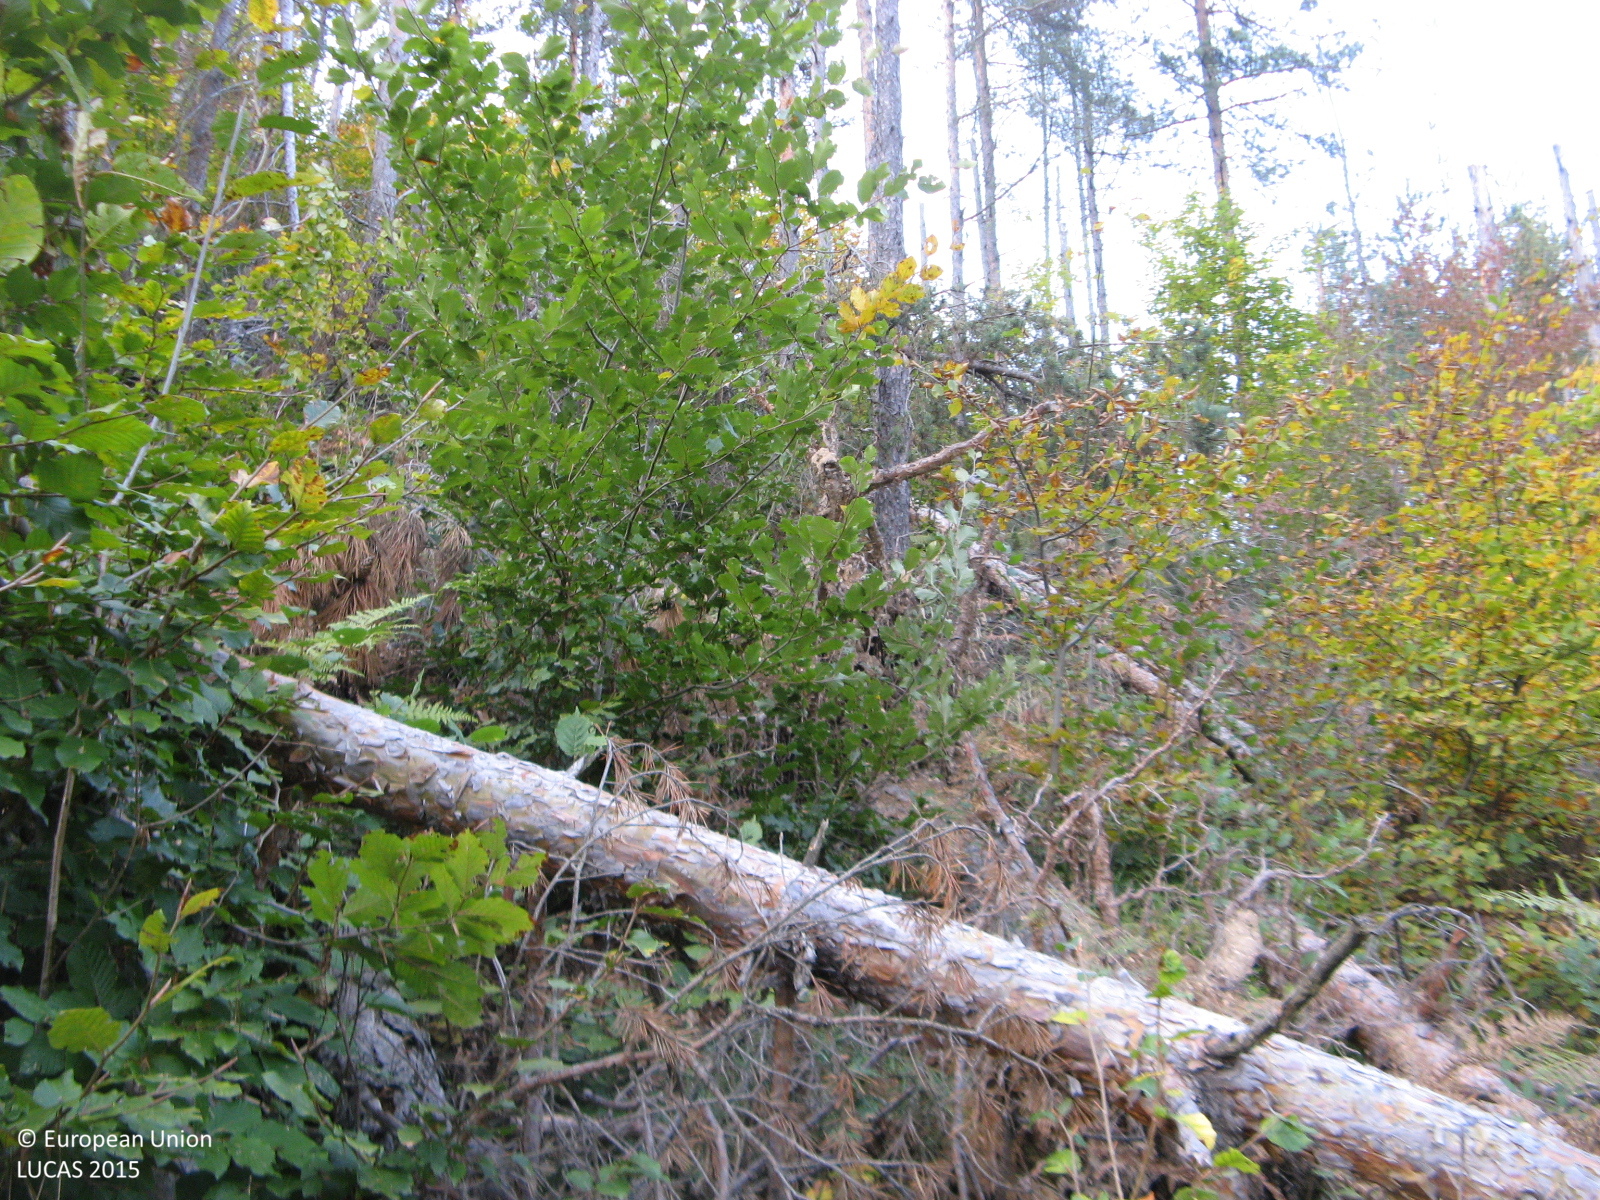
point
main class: Woodland
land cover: Pine dominated mixed woodland
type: hemiboreal forest and nemoral coniferous forest and mixed broadleaved-coniferous forest
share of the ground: > 75 %
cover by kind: coniferous forest trees 75 %, broadleaved forest trees 25 %
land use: Forestry
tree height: > 5 m
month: October
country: BG
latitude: 41.4600
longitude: 24.8545
